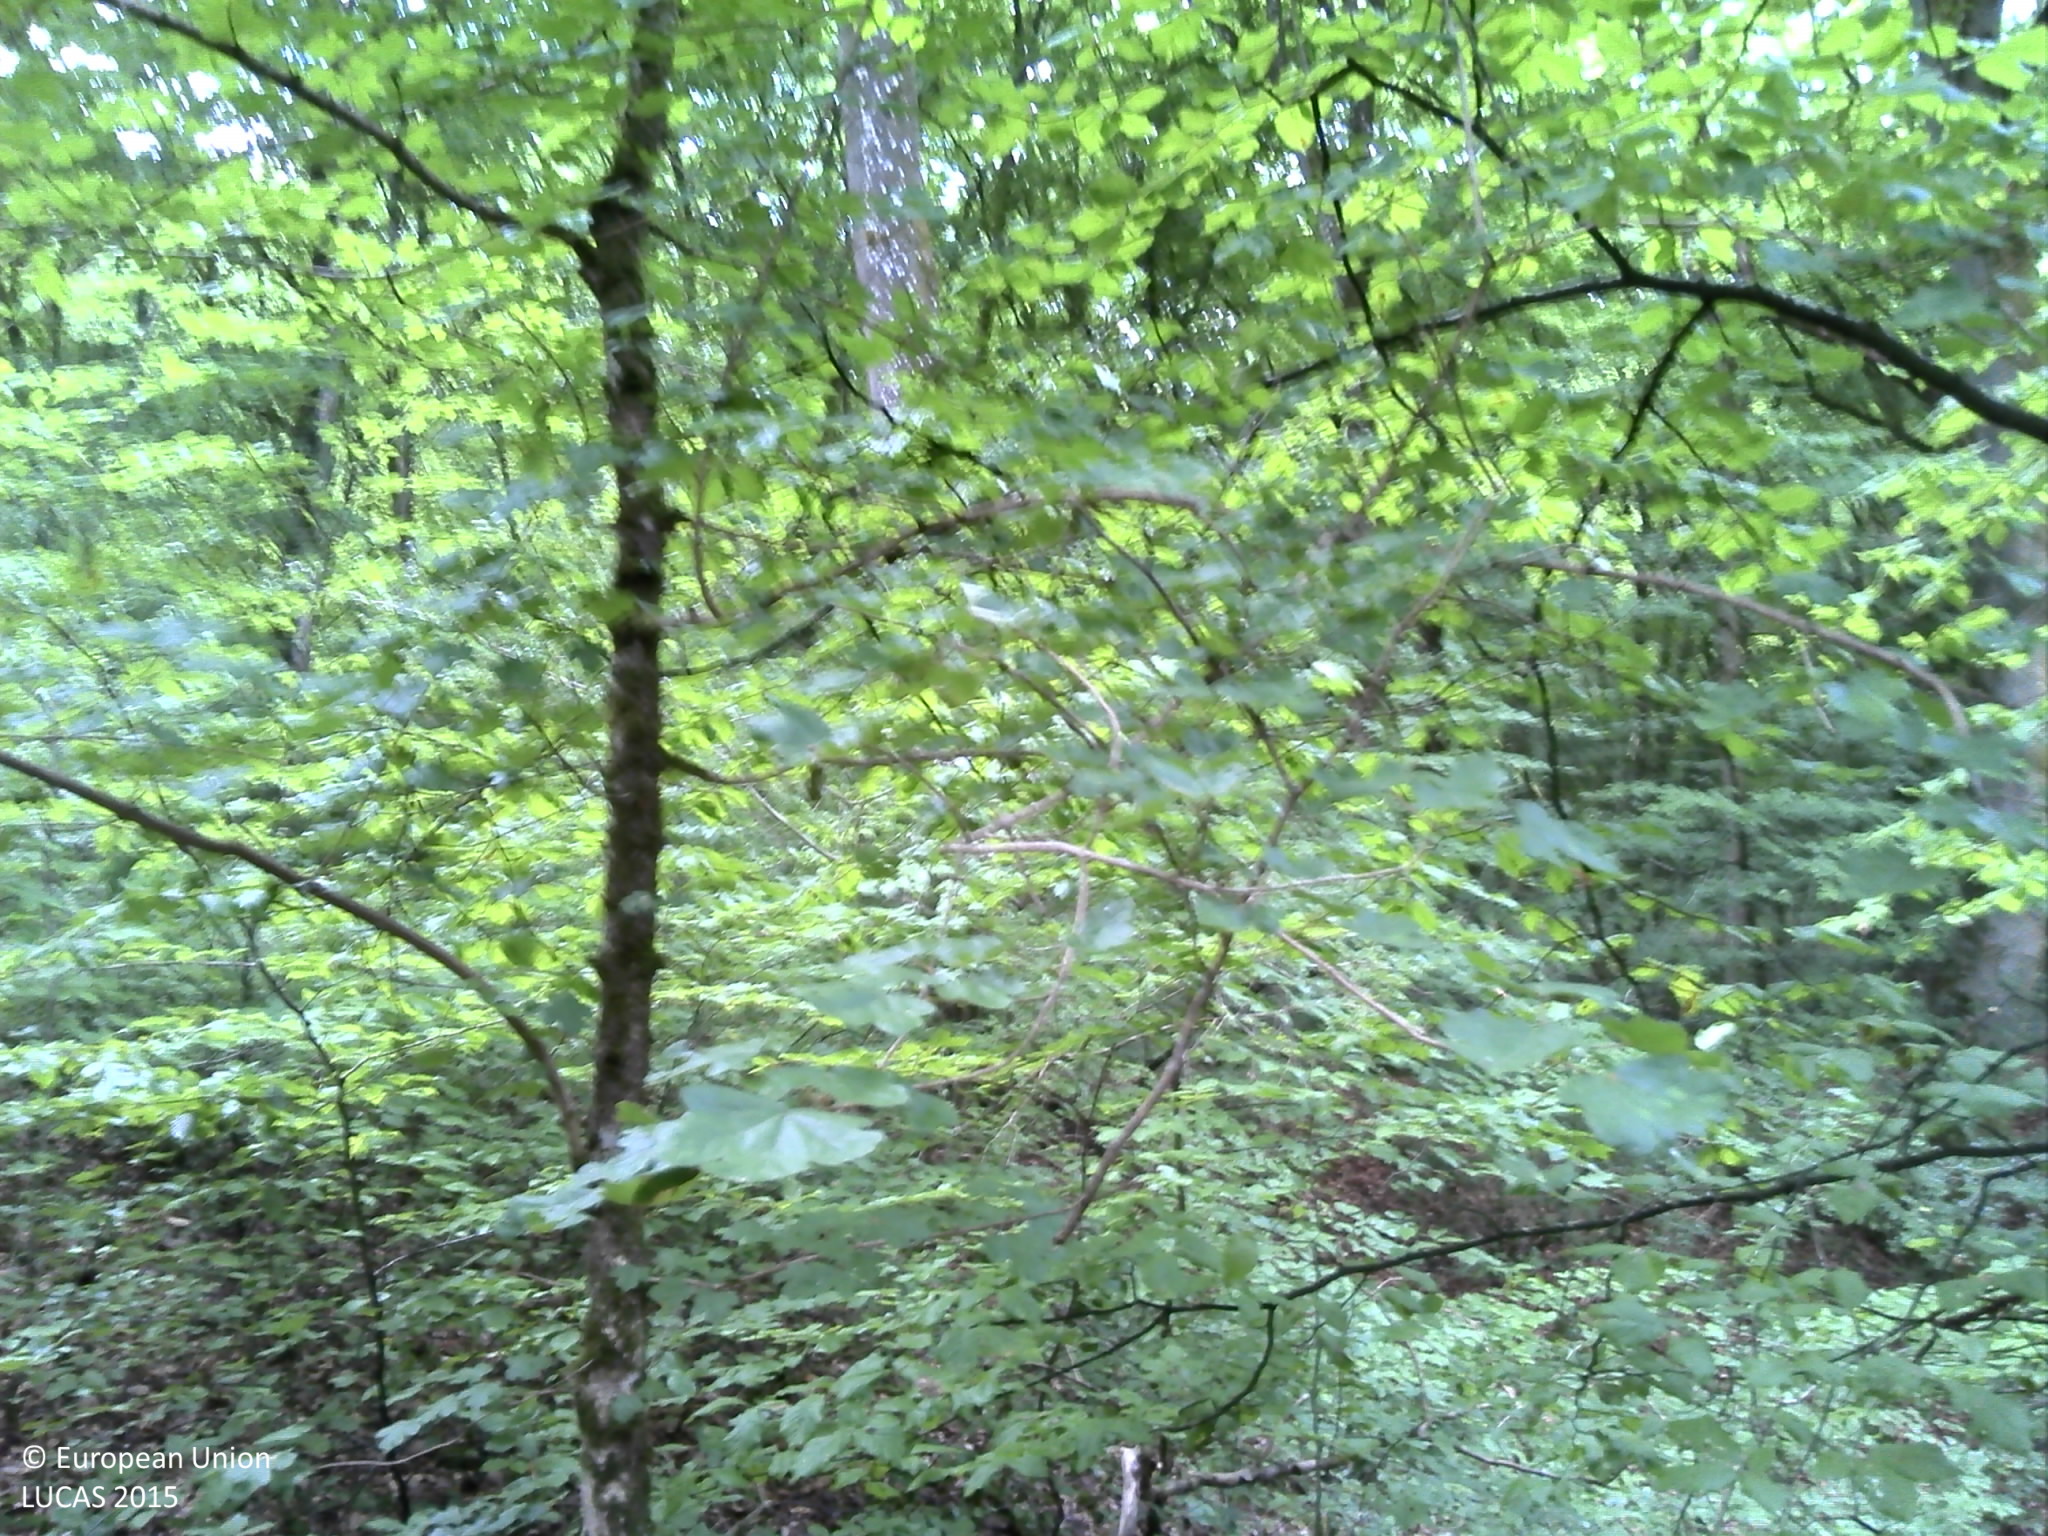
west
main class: Woodland
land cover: Broadleaved woodland
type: acidophilous oak and oak-birch forest
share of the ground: > 75 %
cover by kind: broadleaved forest trees 90 %, herbaceous plants 10 %
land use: Forestry
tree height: > 5 m
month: July
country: FR
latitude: 49.3023
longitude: 6.4930
